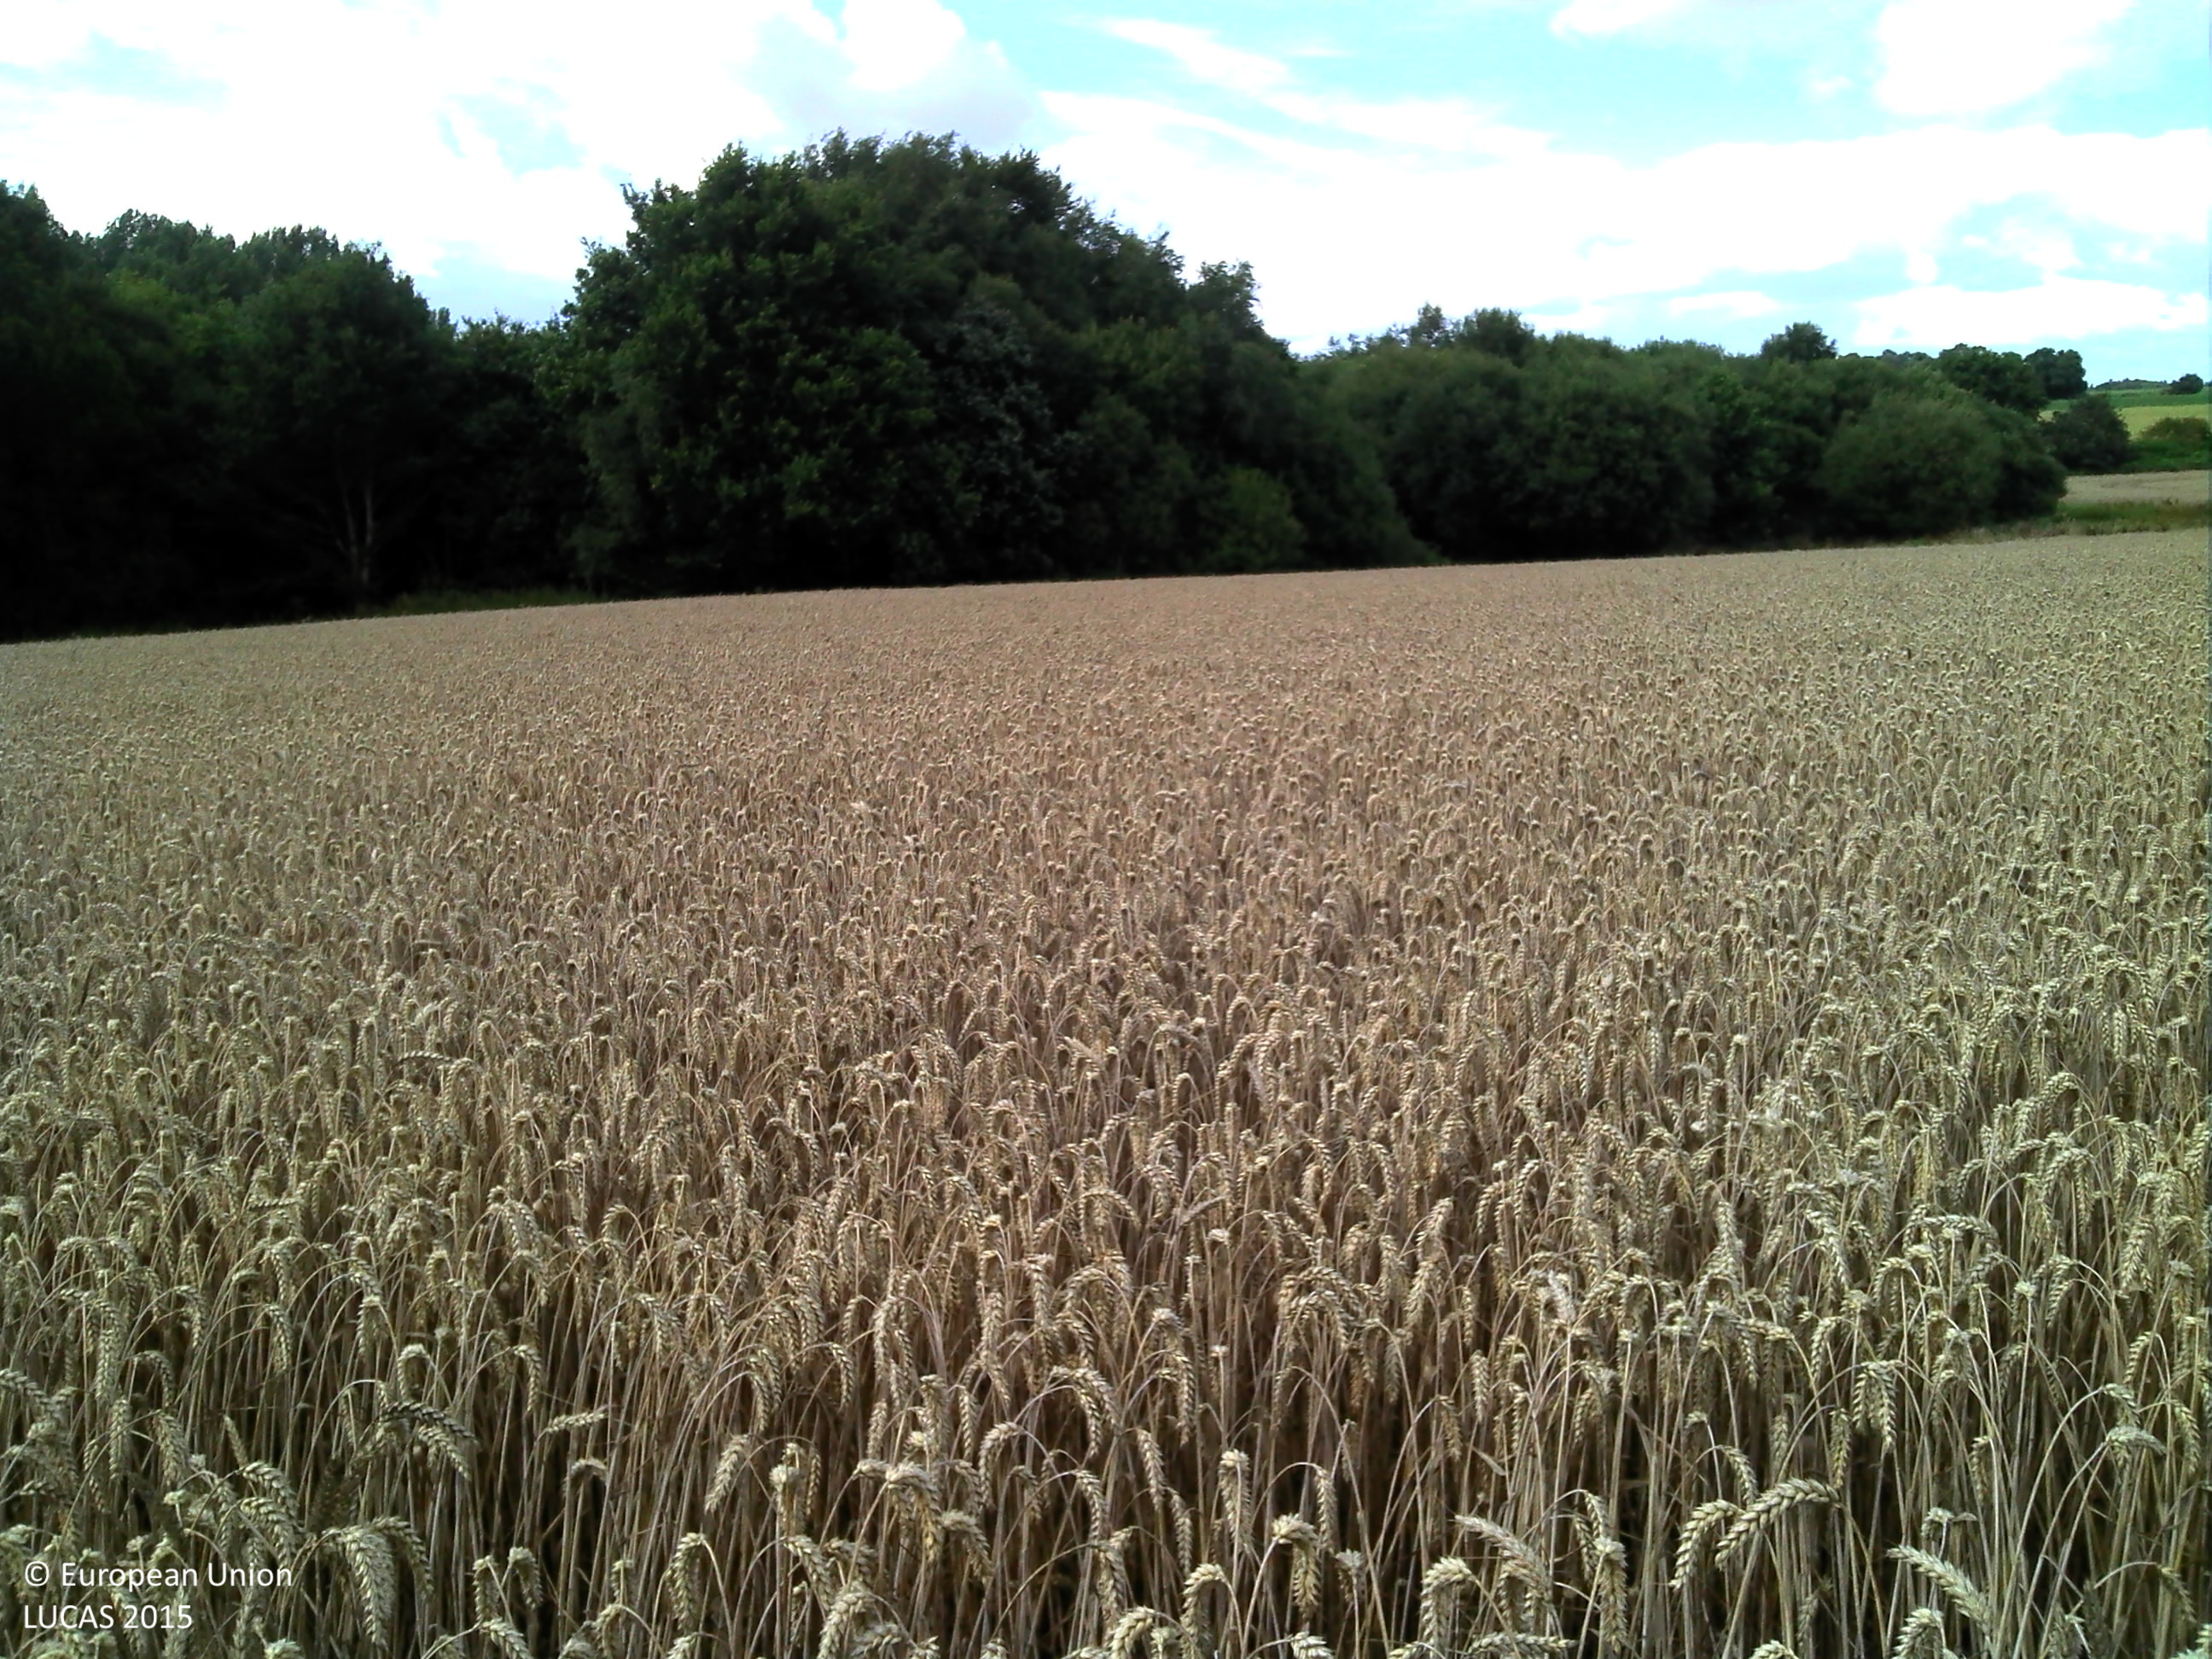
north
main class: Cropland
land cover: Common wheat
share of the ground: > 75 %
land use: Agriculture (excluding fallow land and kitchen gardens)
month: July
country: FR
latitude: 47.9226
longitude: -3.0085
